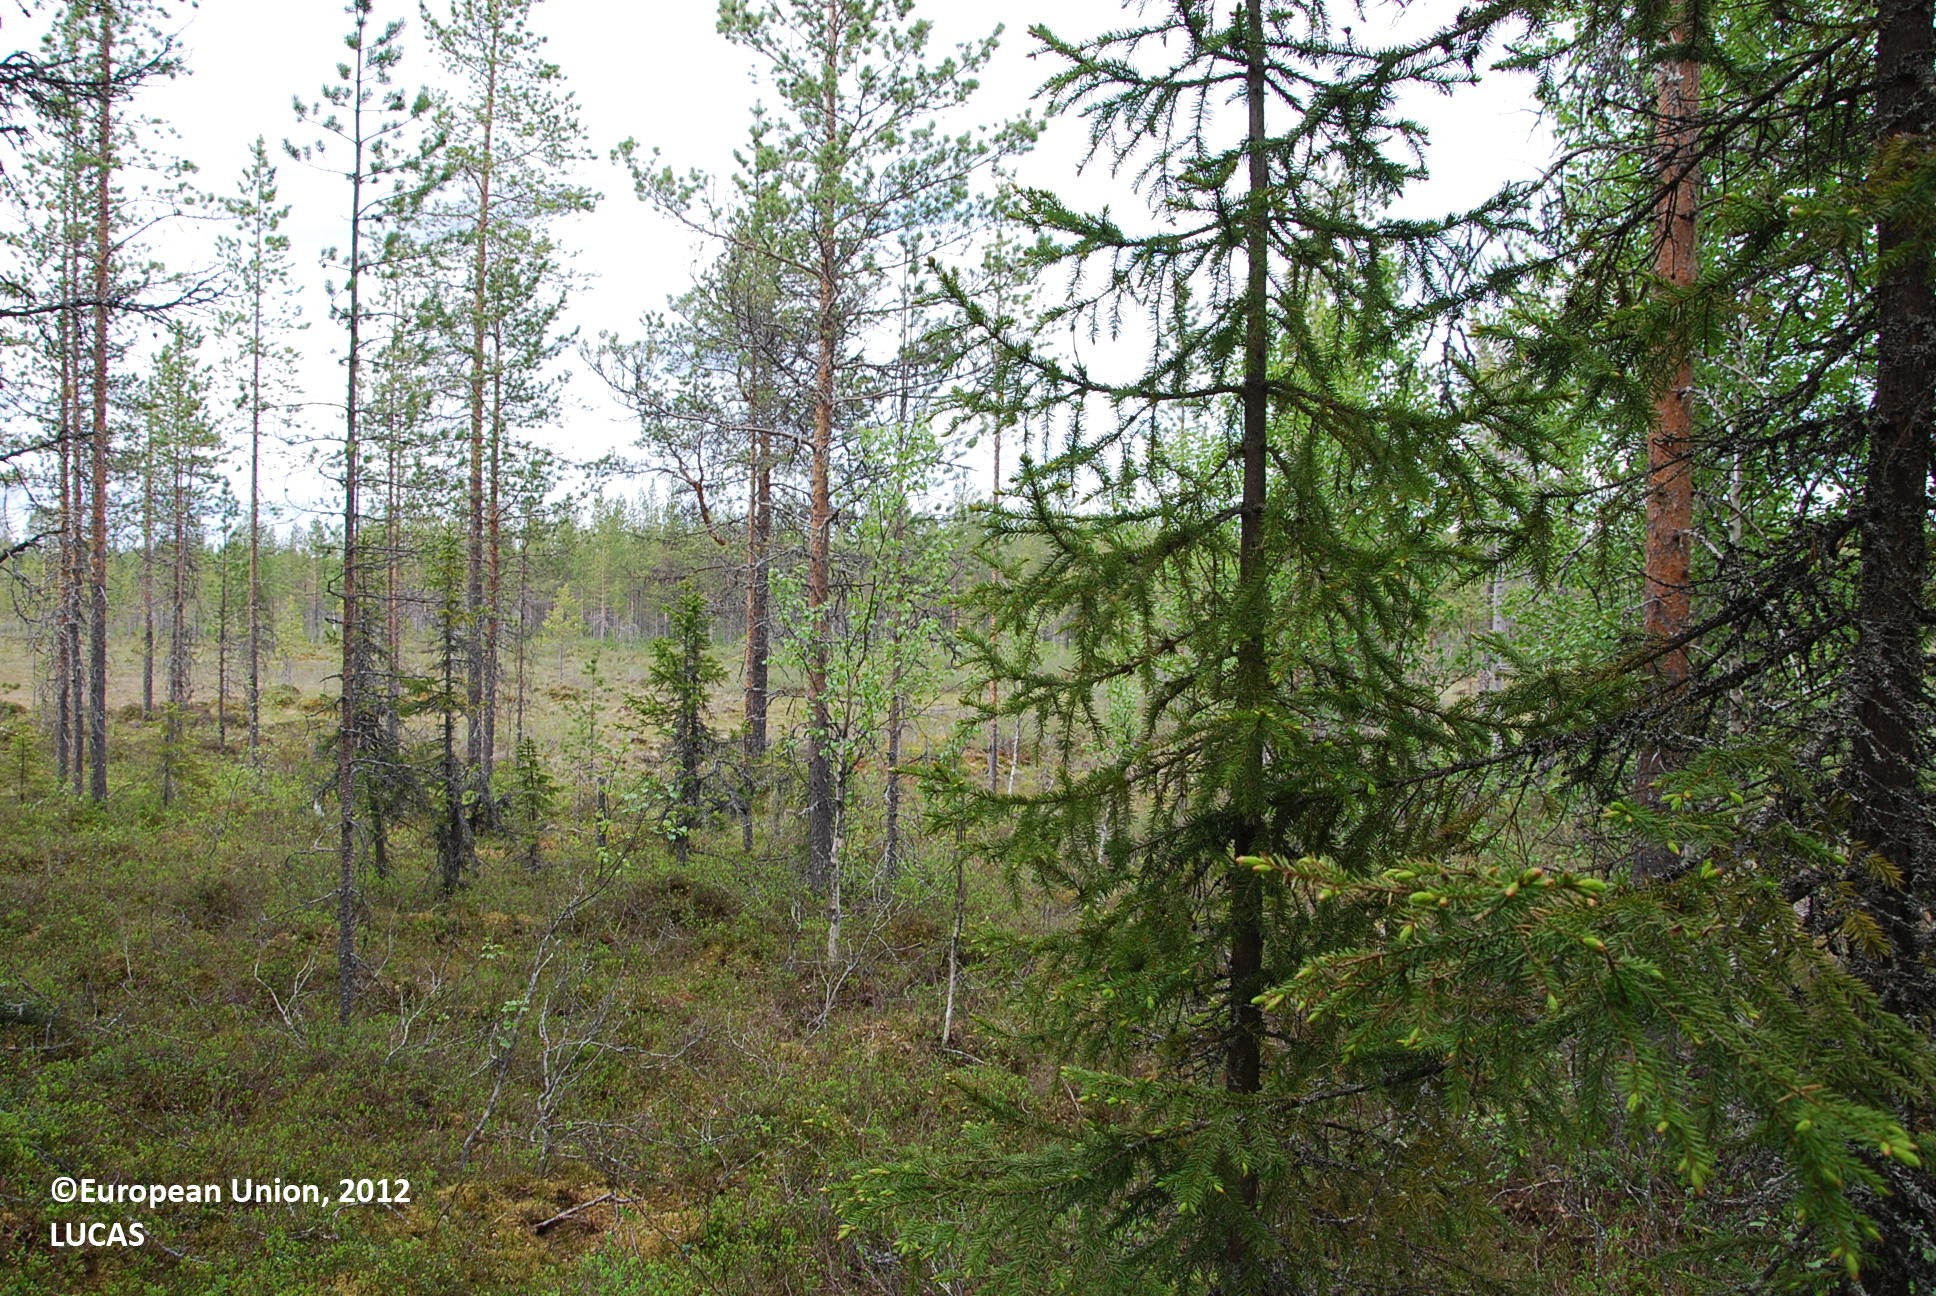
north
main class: Woodland
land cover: Pine dominated mixed woodland
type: boreal forest
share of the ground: > 75 %
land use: Forestry
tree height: > 5 m
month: June
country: FI
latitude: 66.0406
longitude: 27.6708
